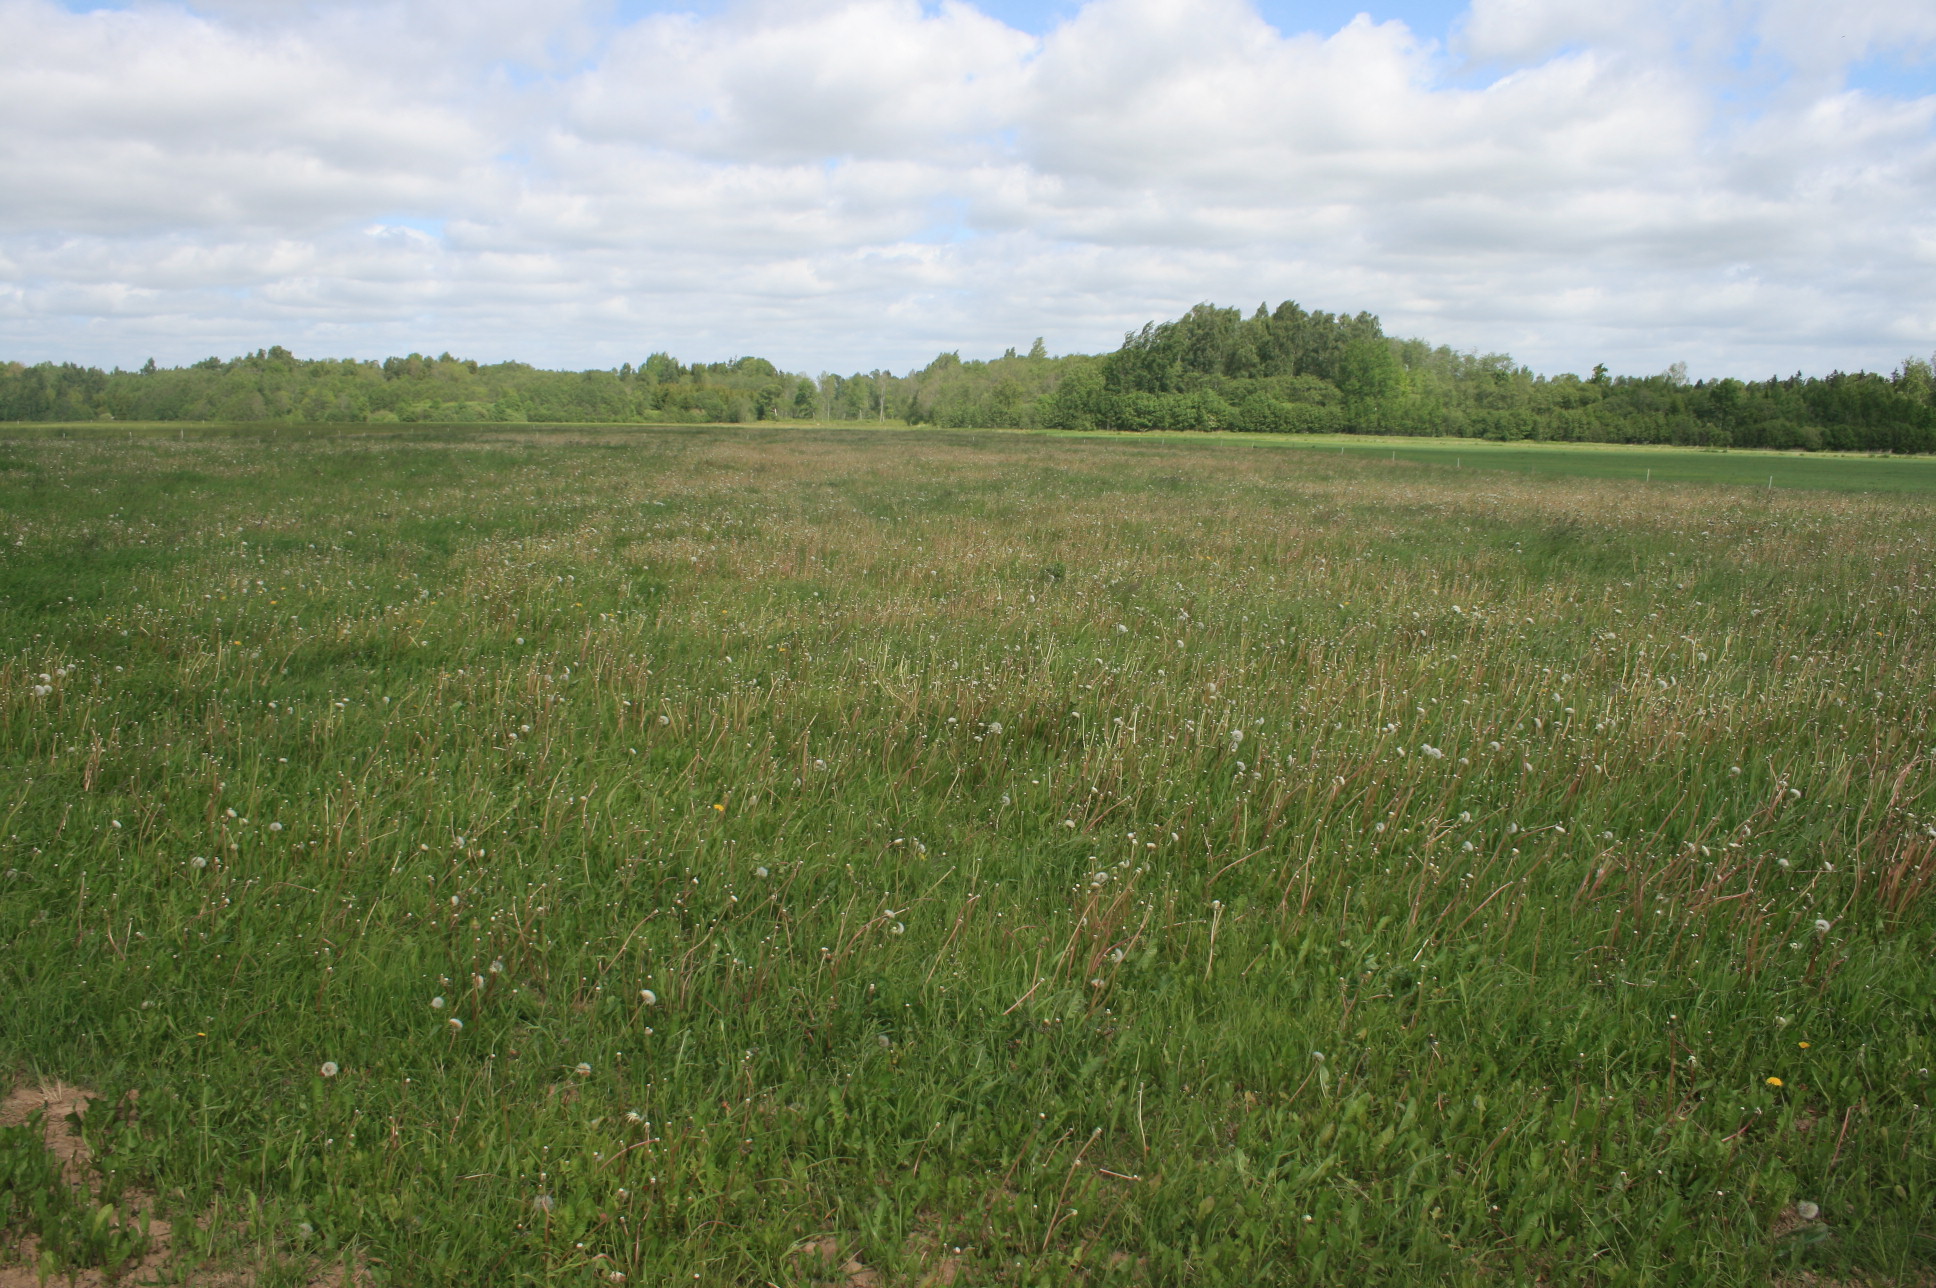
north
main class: Cropland
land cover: Other leguminous and mixtures for fodder
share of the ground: < 10 %
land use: Agriculture (excluding fallow land and kitchen gardens)
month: June
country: LT
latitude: 56.1893
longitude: 22.3508
